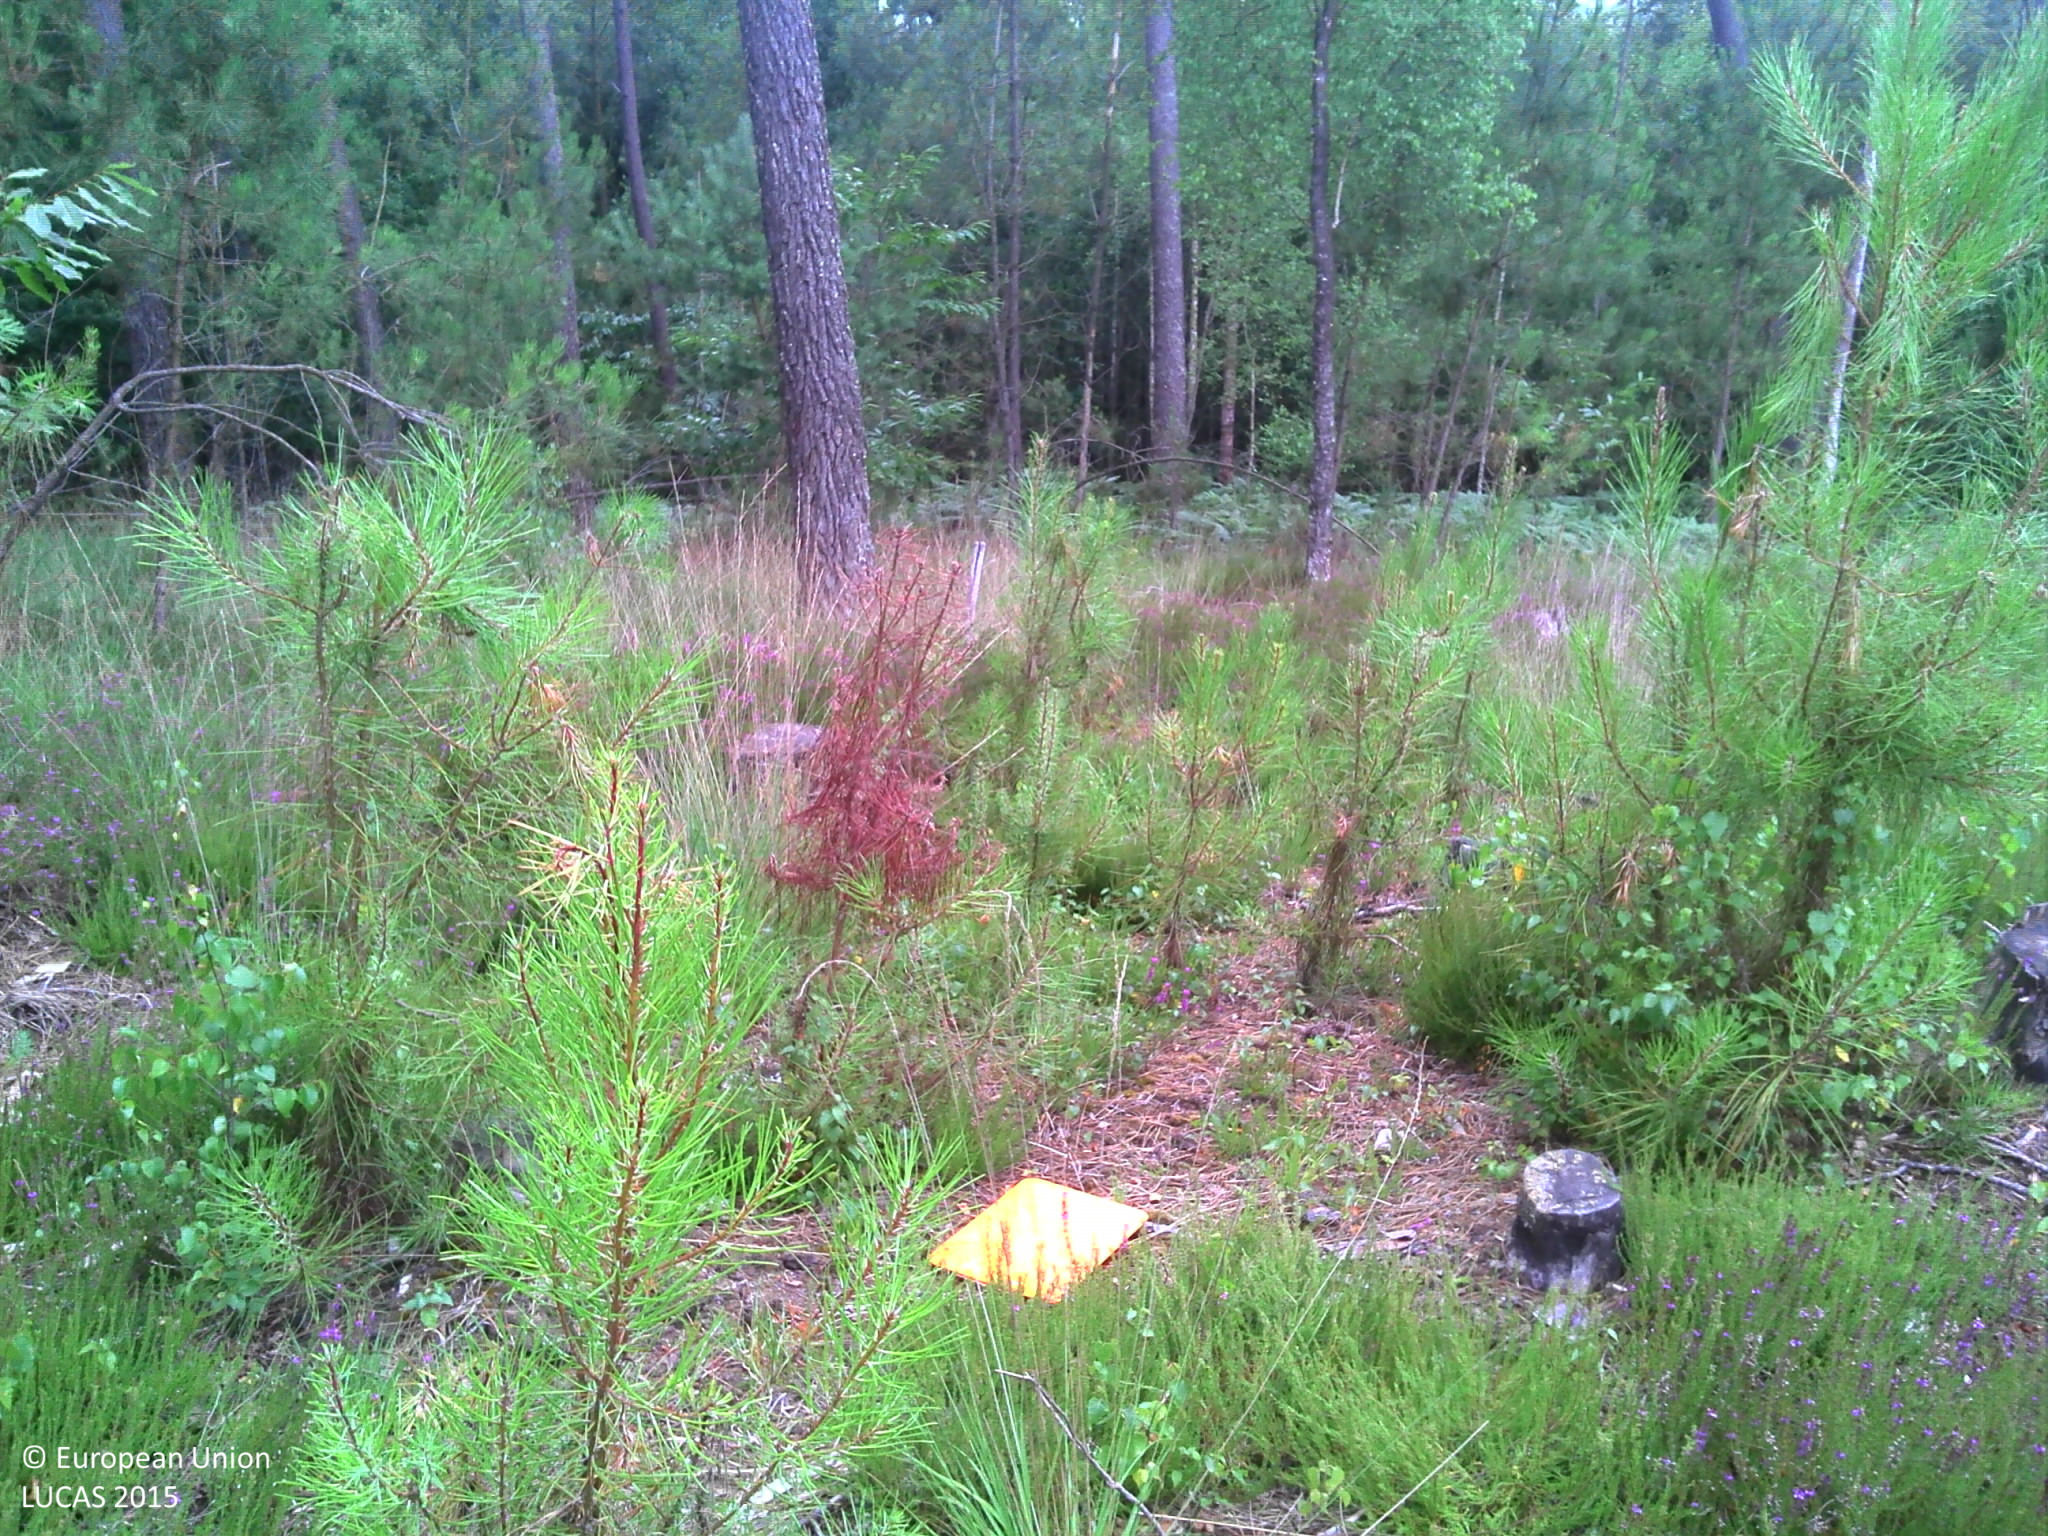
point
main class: Woodland
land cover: Pine dominated coniferous woodland
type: exotic forest
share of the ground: 50 - 75 %
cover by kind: coniferous forest trees 50 %, herbaceous plants 30 %, shrubs 20 %
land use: Forestry
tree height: < 5 m
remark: Nursery
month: July
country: FR
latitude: 47.8776
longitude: 0.4161
